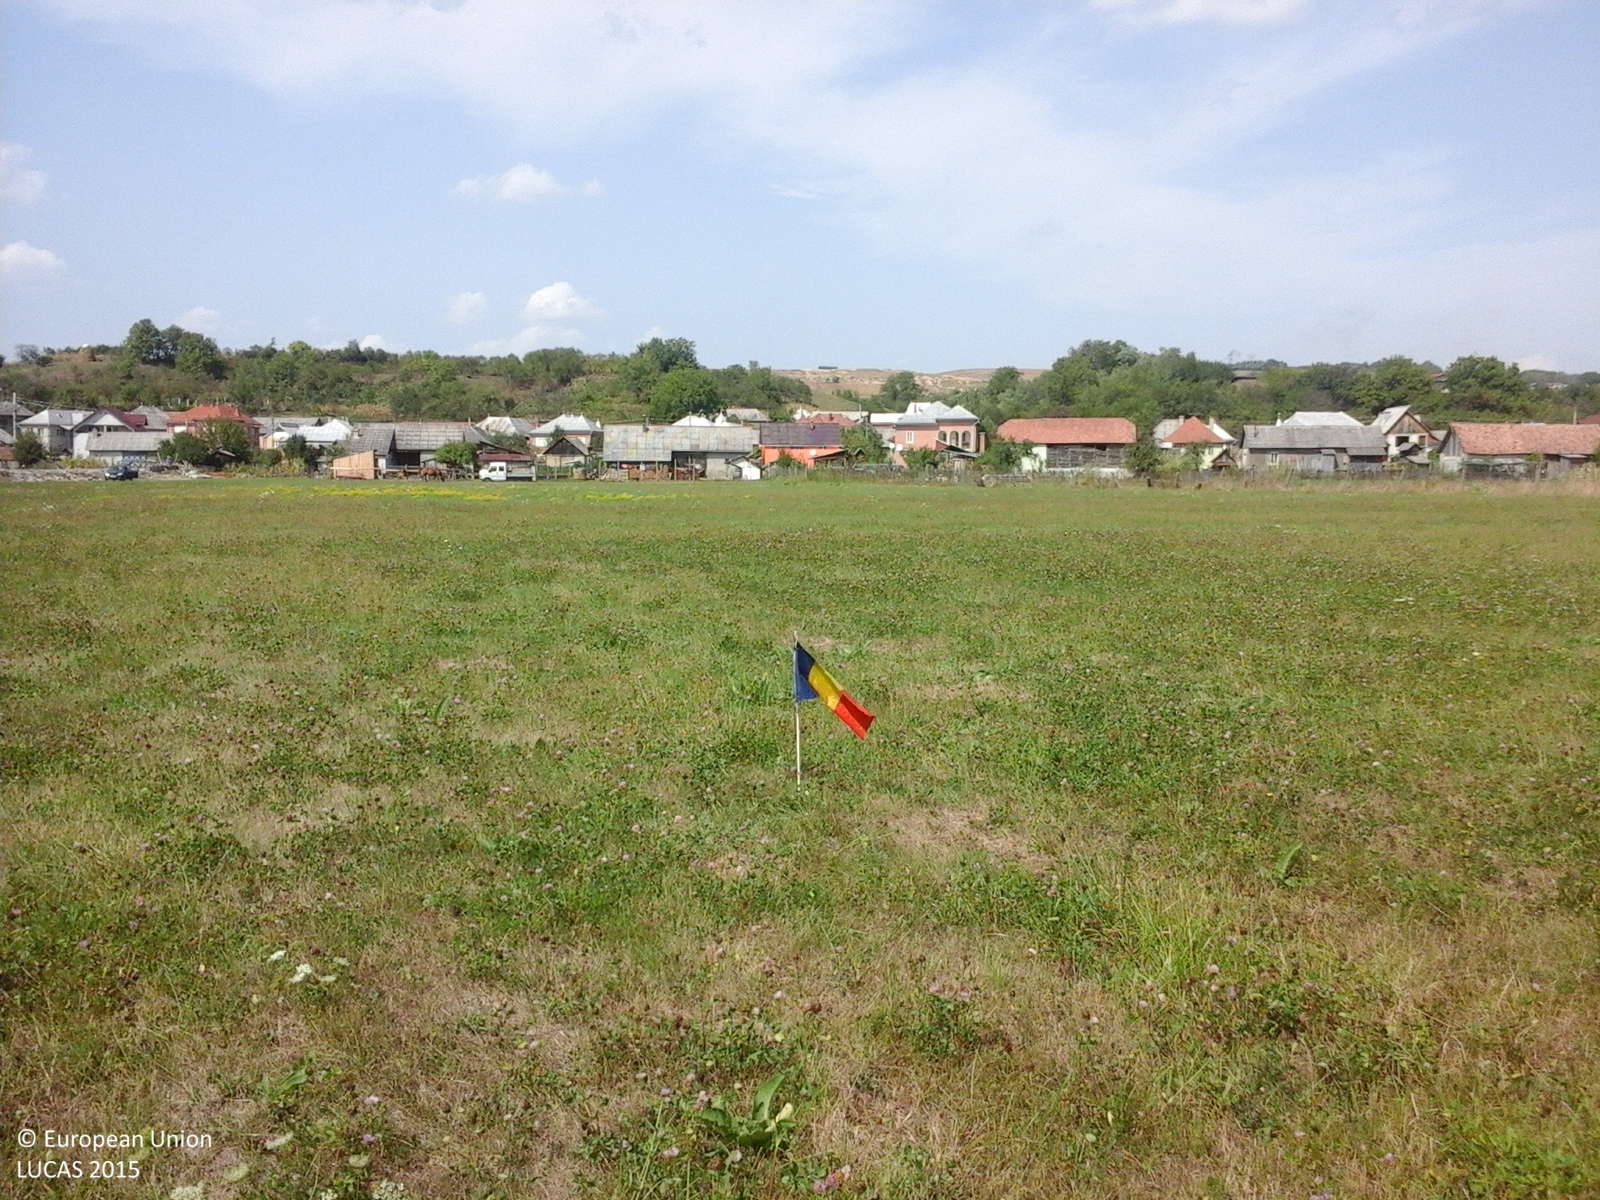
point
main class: Grassland
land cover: Grassland without tree/shrub cover
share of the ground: > 75 %
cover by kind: herbaceous plants 100 %
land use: Agriculture (excluding fallow land and kitchen gardens)
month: September
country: RO
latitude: 47.2317
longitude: 24.1514
